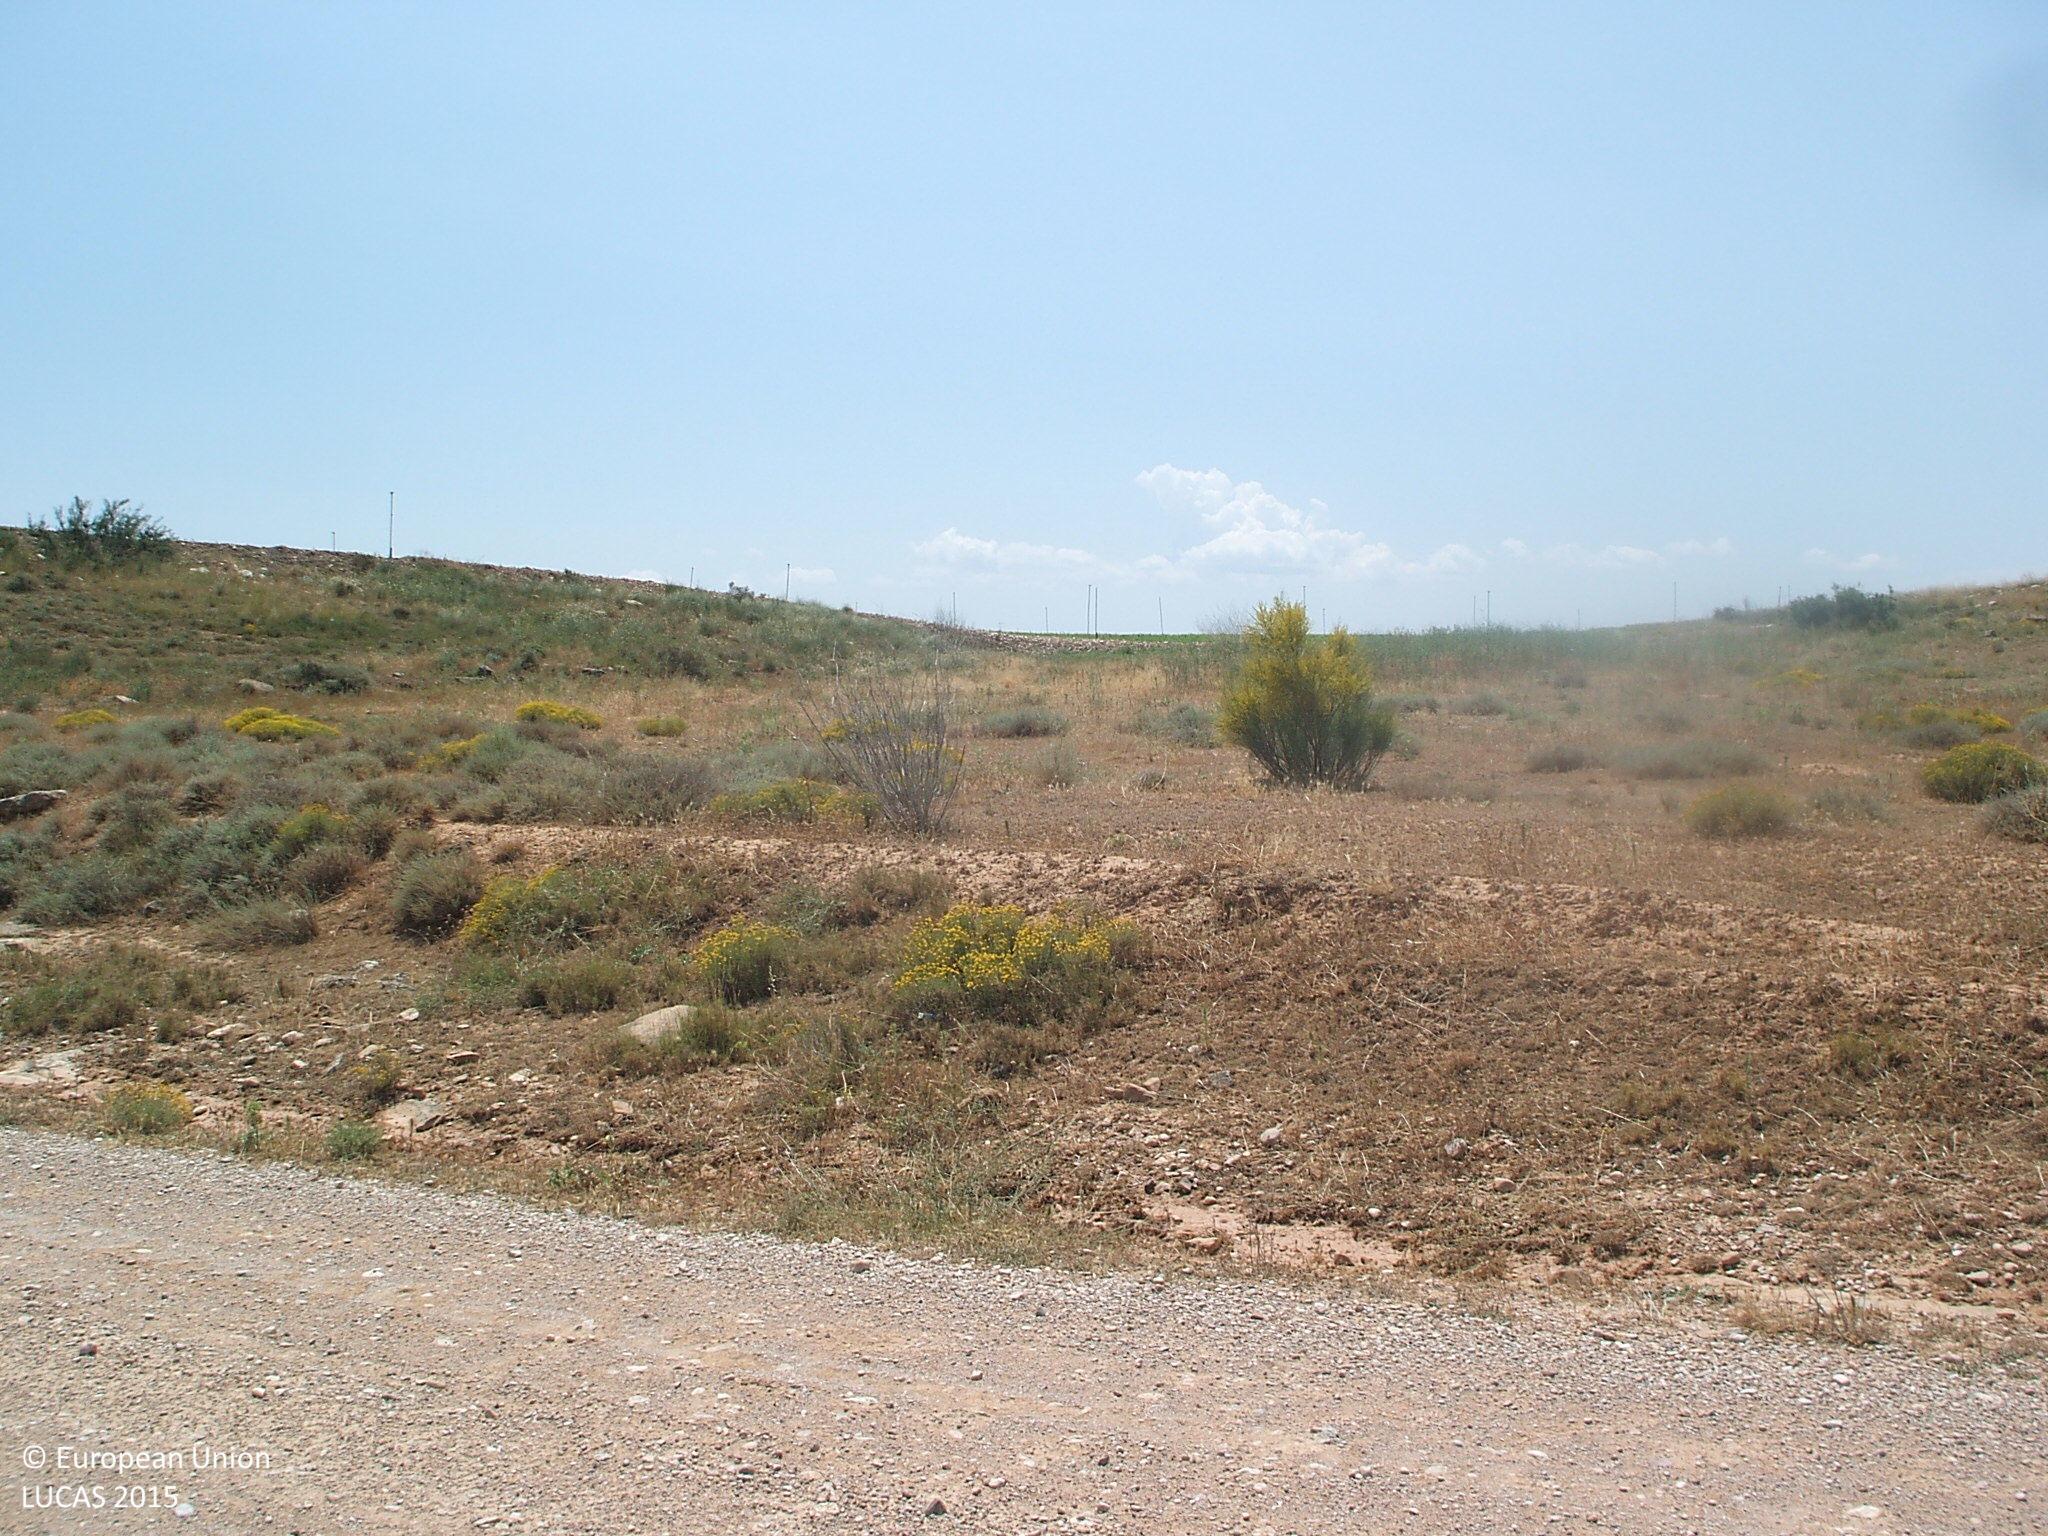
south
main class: Shrubland
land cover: Shrubland without tree cover
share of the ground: > 75 %
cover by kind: shrubs 90 %, herbaceous plants 10 %
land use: Semi-natural and natural areas not in use
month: June
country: ES
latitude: 41.0476
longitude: -0.1836
